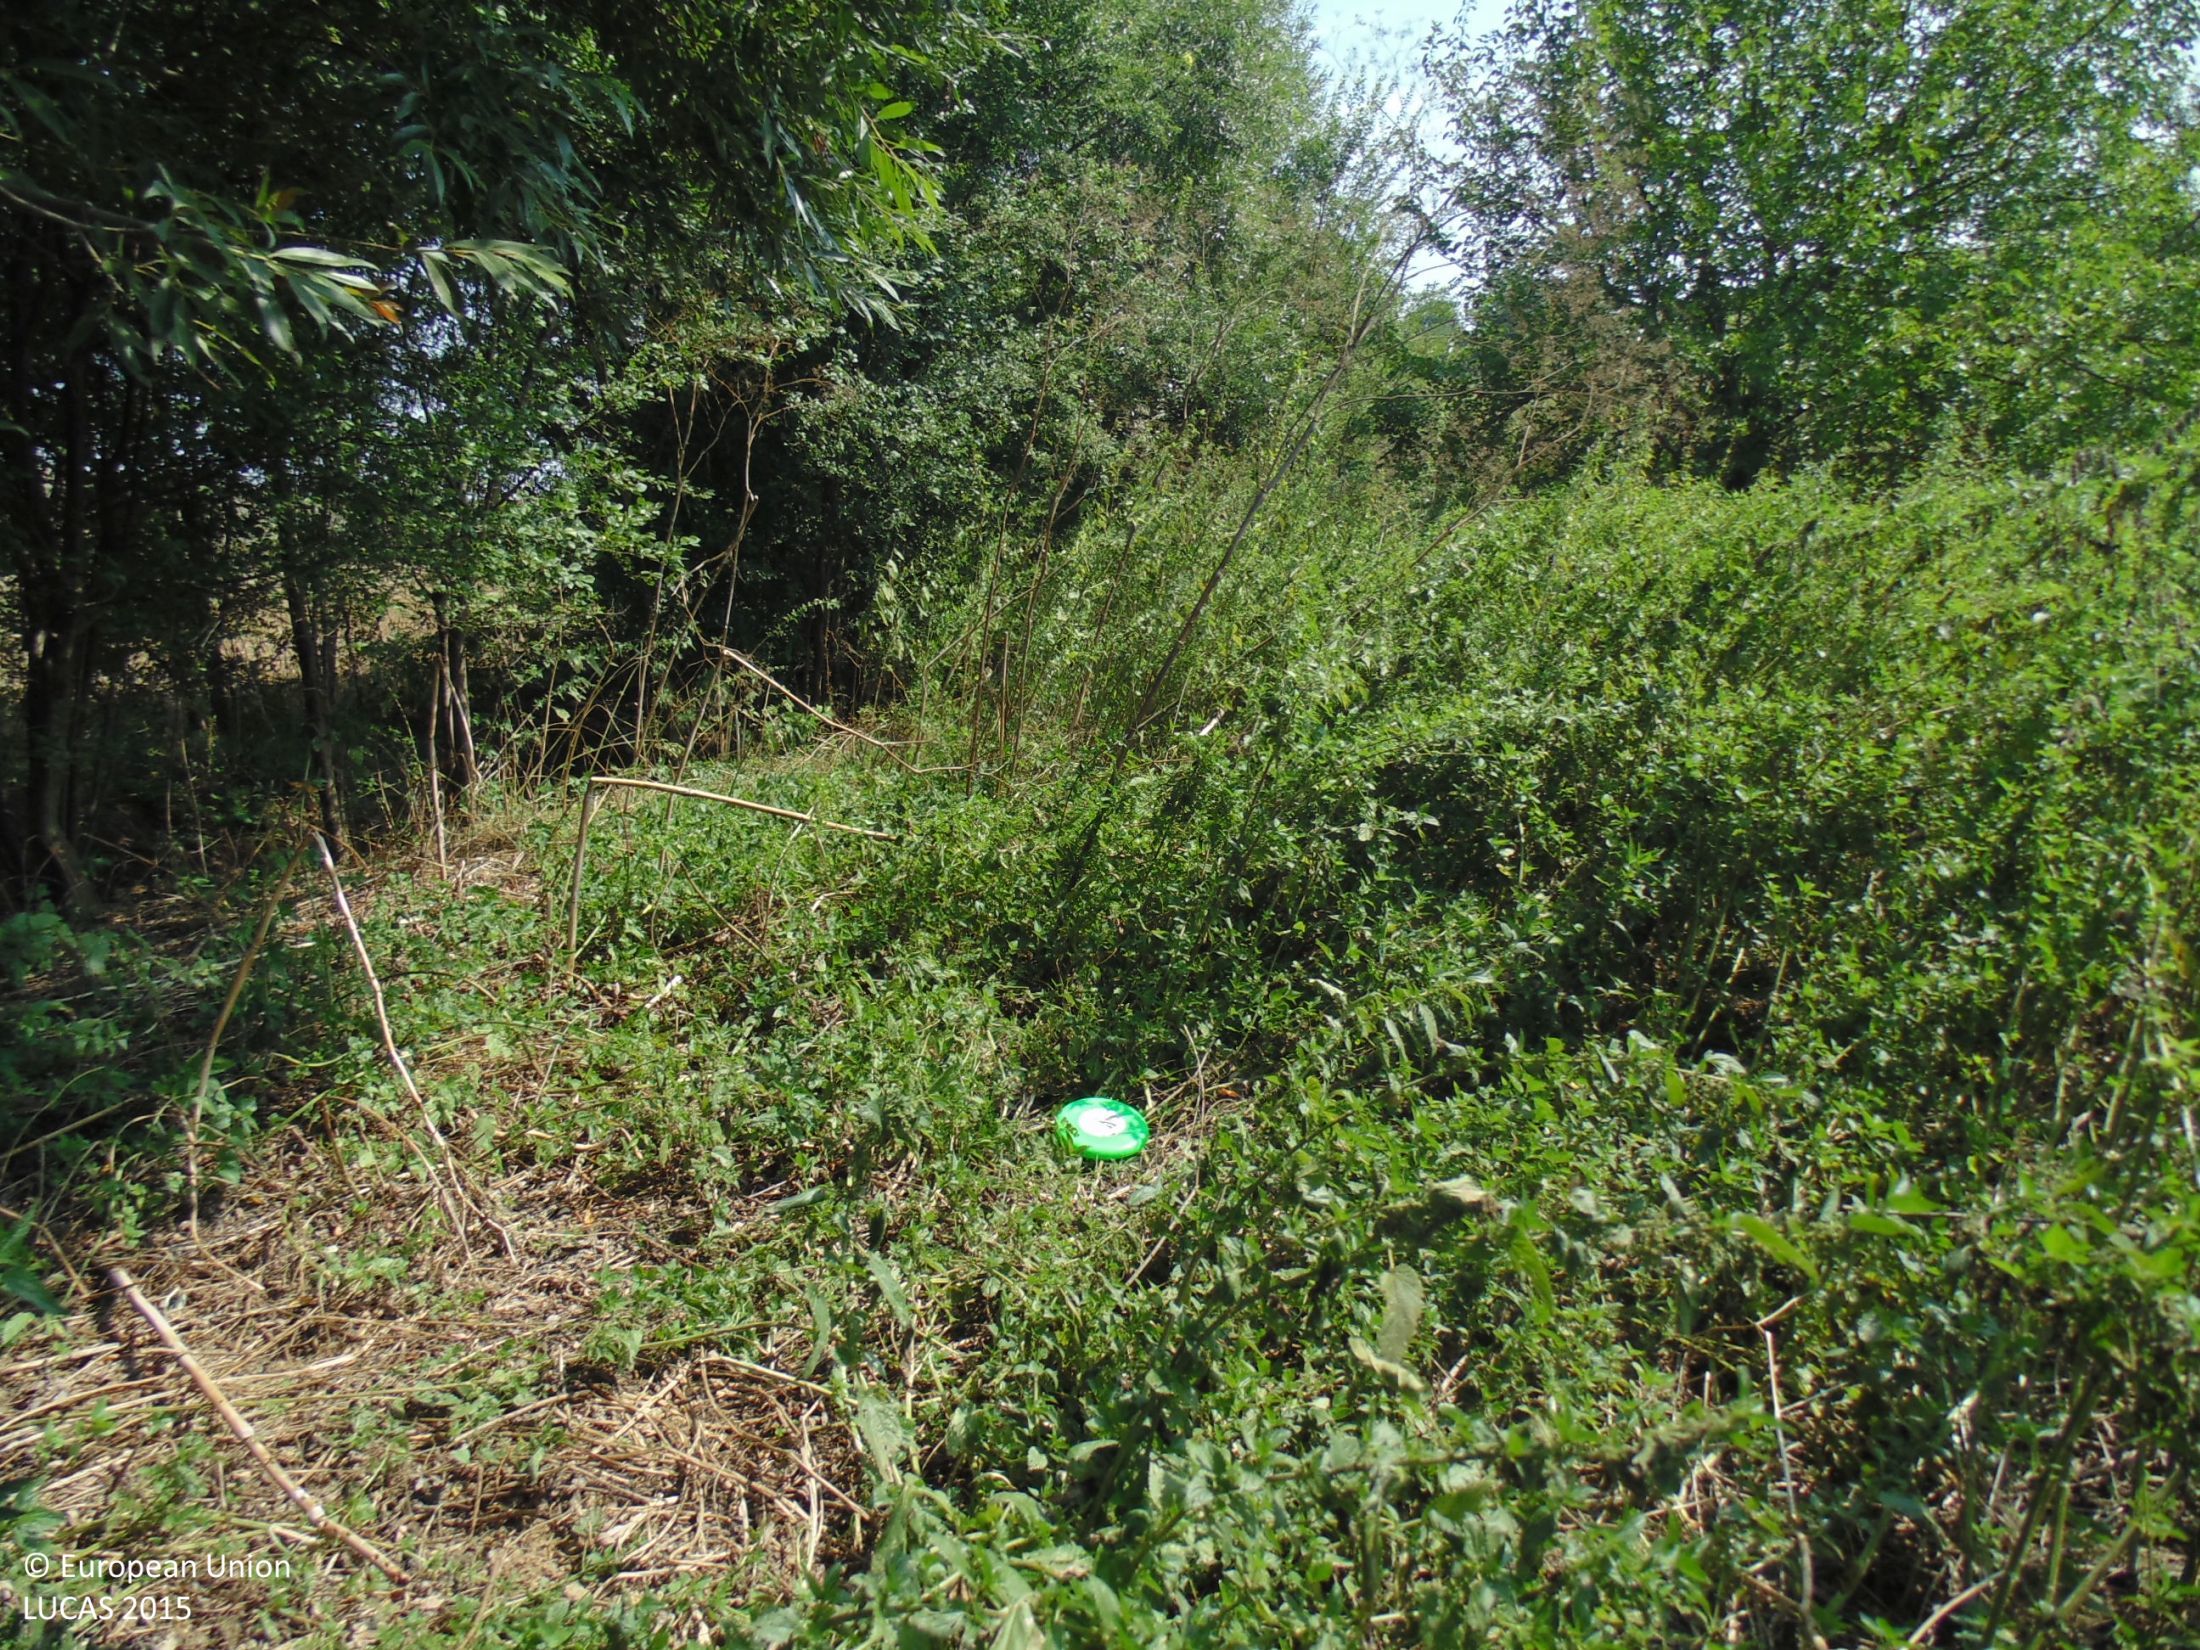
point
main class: Woodland
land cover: Broadleaved woodland
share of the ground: 50 - 75 %
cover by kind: broadleaved forest trees 50 %, herbaceous plants 45 %, shrubs 5 %
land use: Semi-natural and natural areas not in use
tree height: > 5 m
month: August
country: BG
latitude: 44.0195
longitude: 27.3357
